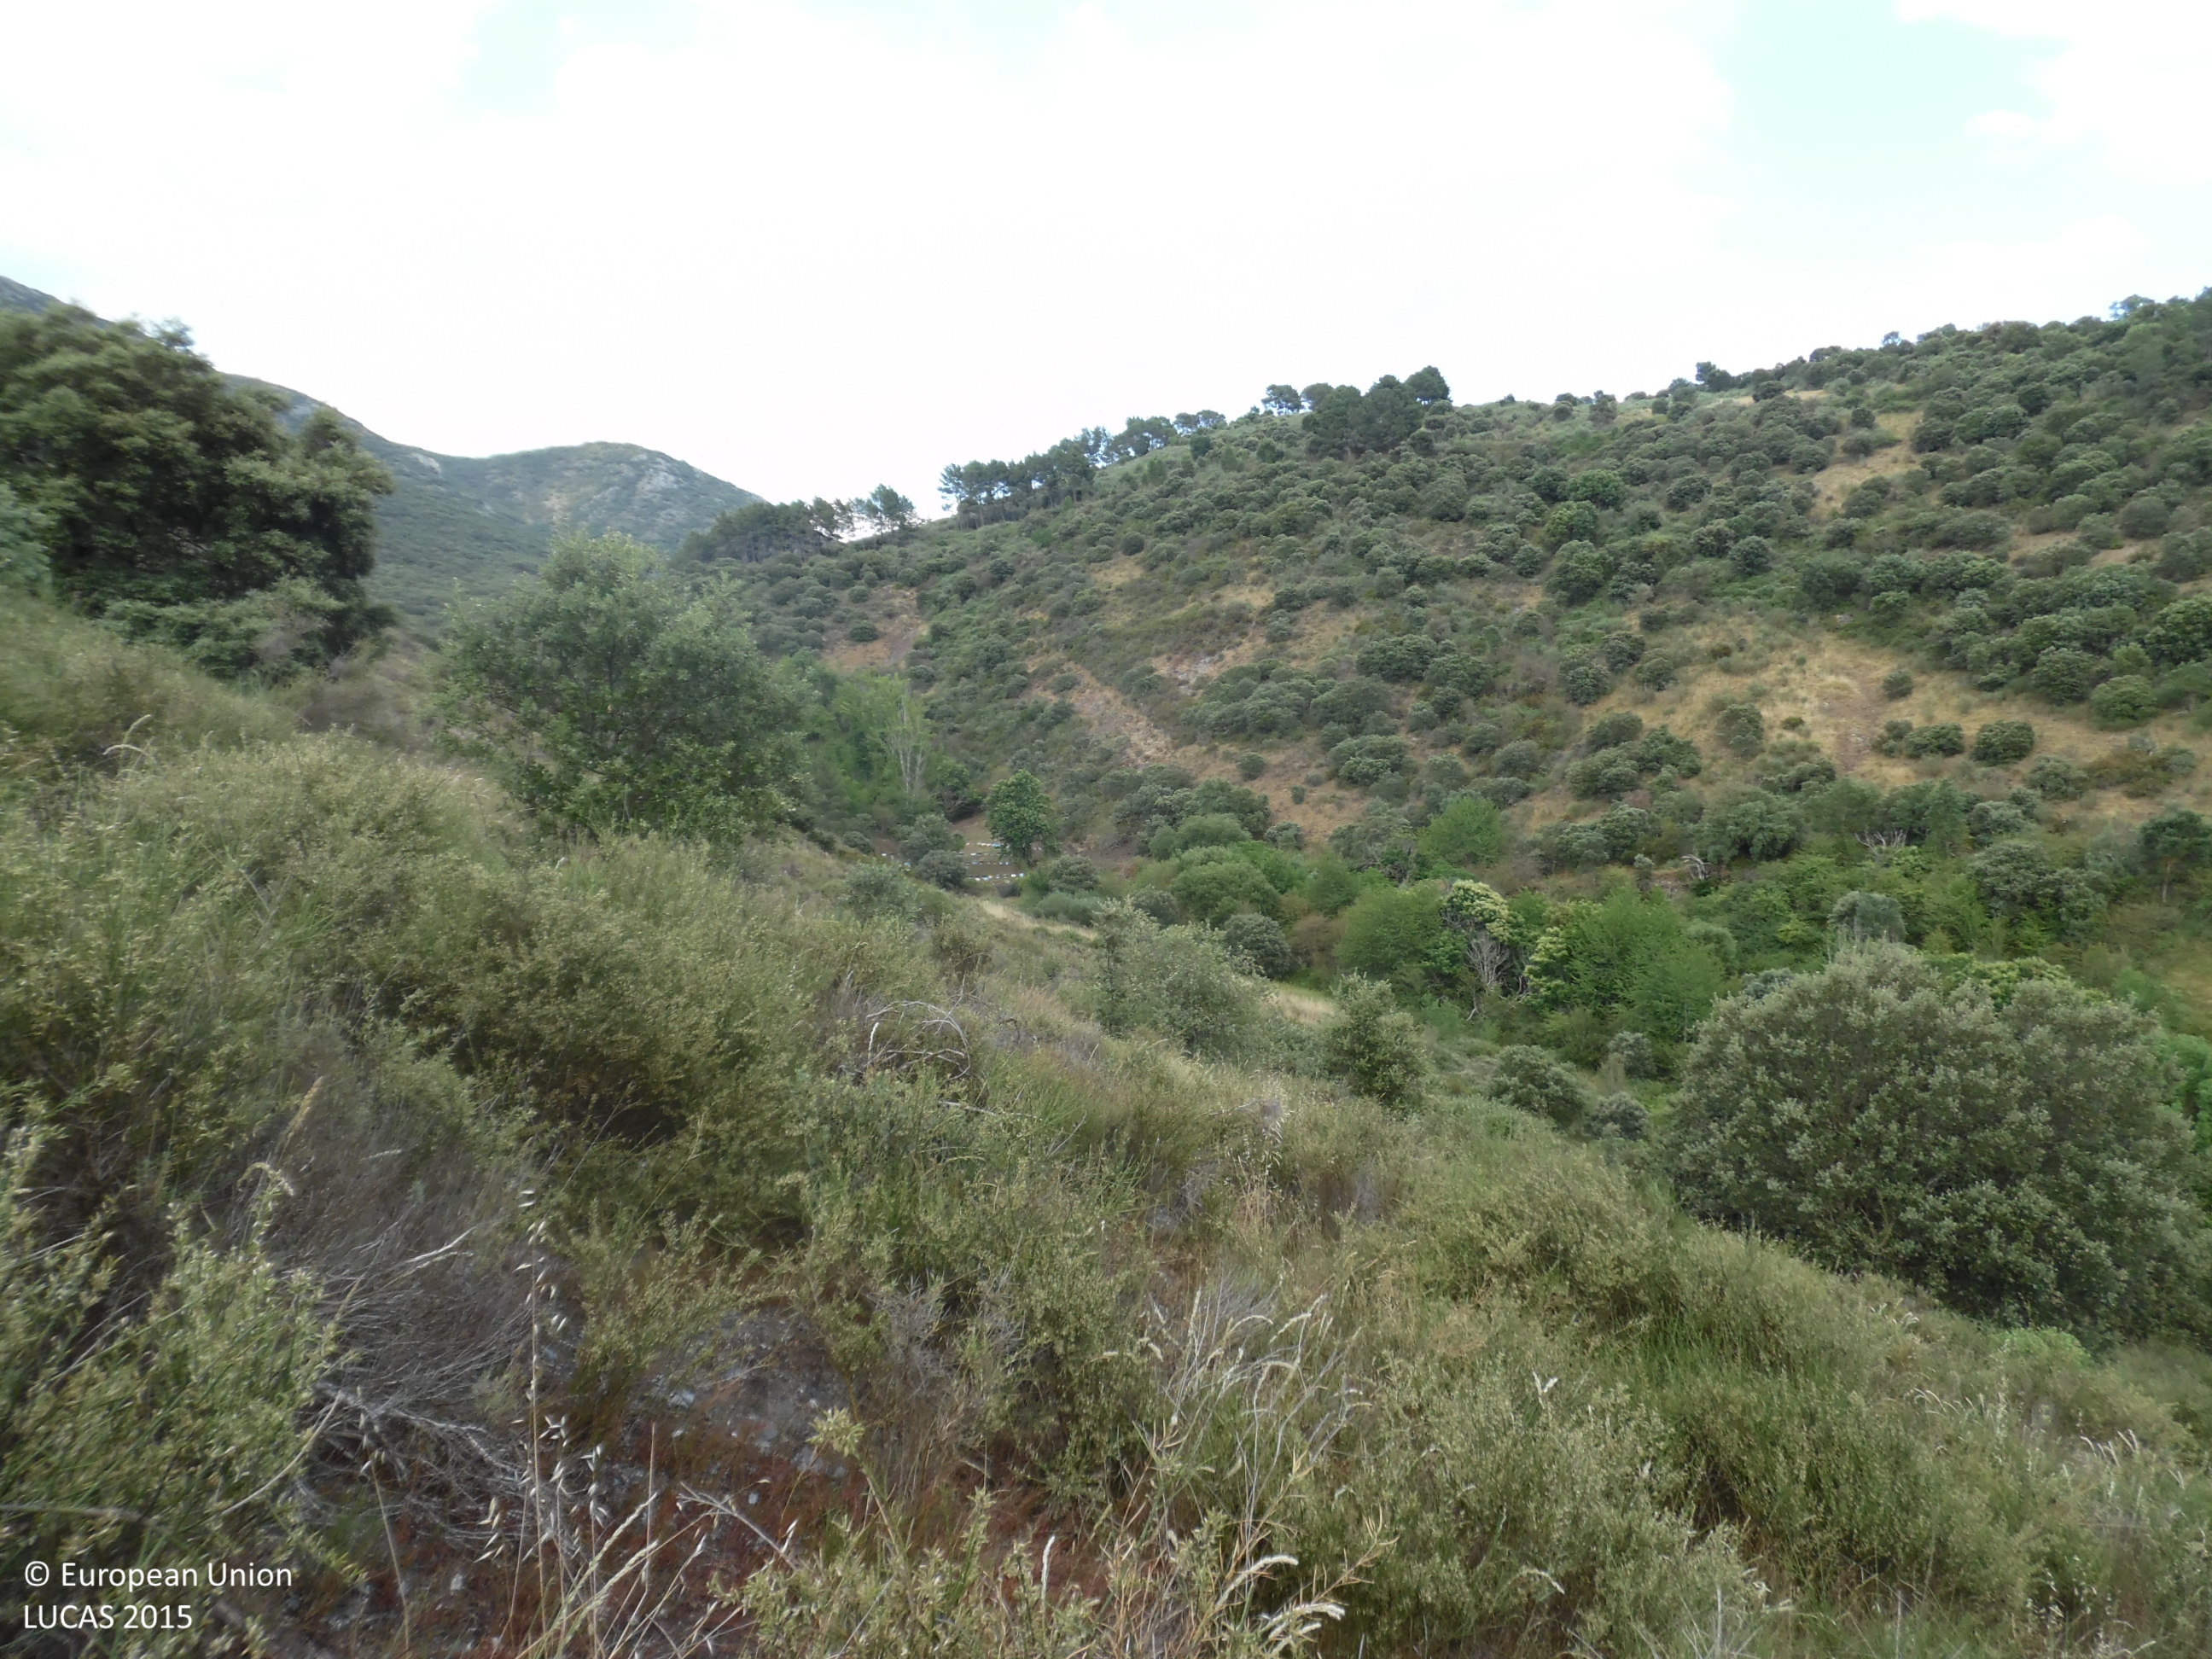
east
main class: Shrubland
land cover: Shrubland with sparse tree cover
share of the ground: > 75 %
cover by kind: shrubs 95 %, broadleaved forest trees 5 %
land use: Abandoned areas
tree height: < 5 m
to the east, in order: Shrubland with sparse tree cover; Tracks; Shrubland with sparse tree cover; Rock outcrops; Shrubland with sparse tree cover; Dry stone walls; Grassland without tree/shrub cover; Dry stone walls; Tracks; Broadleaved woodland; Rivers and streams; Broadleaved woodland
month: June
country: ES
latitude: 42.4507
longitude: -6.8180
